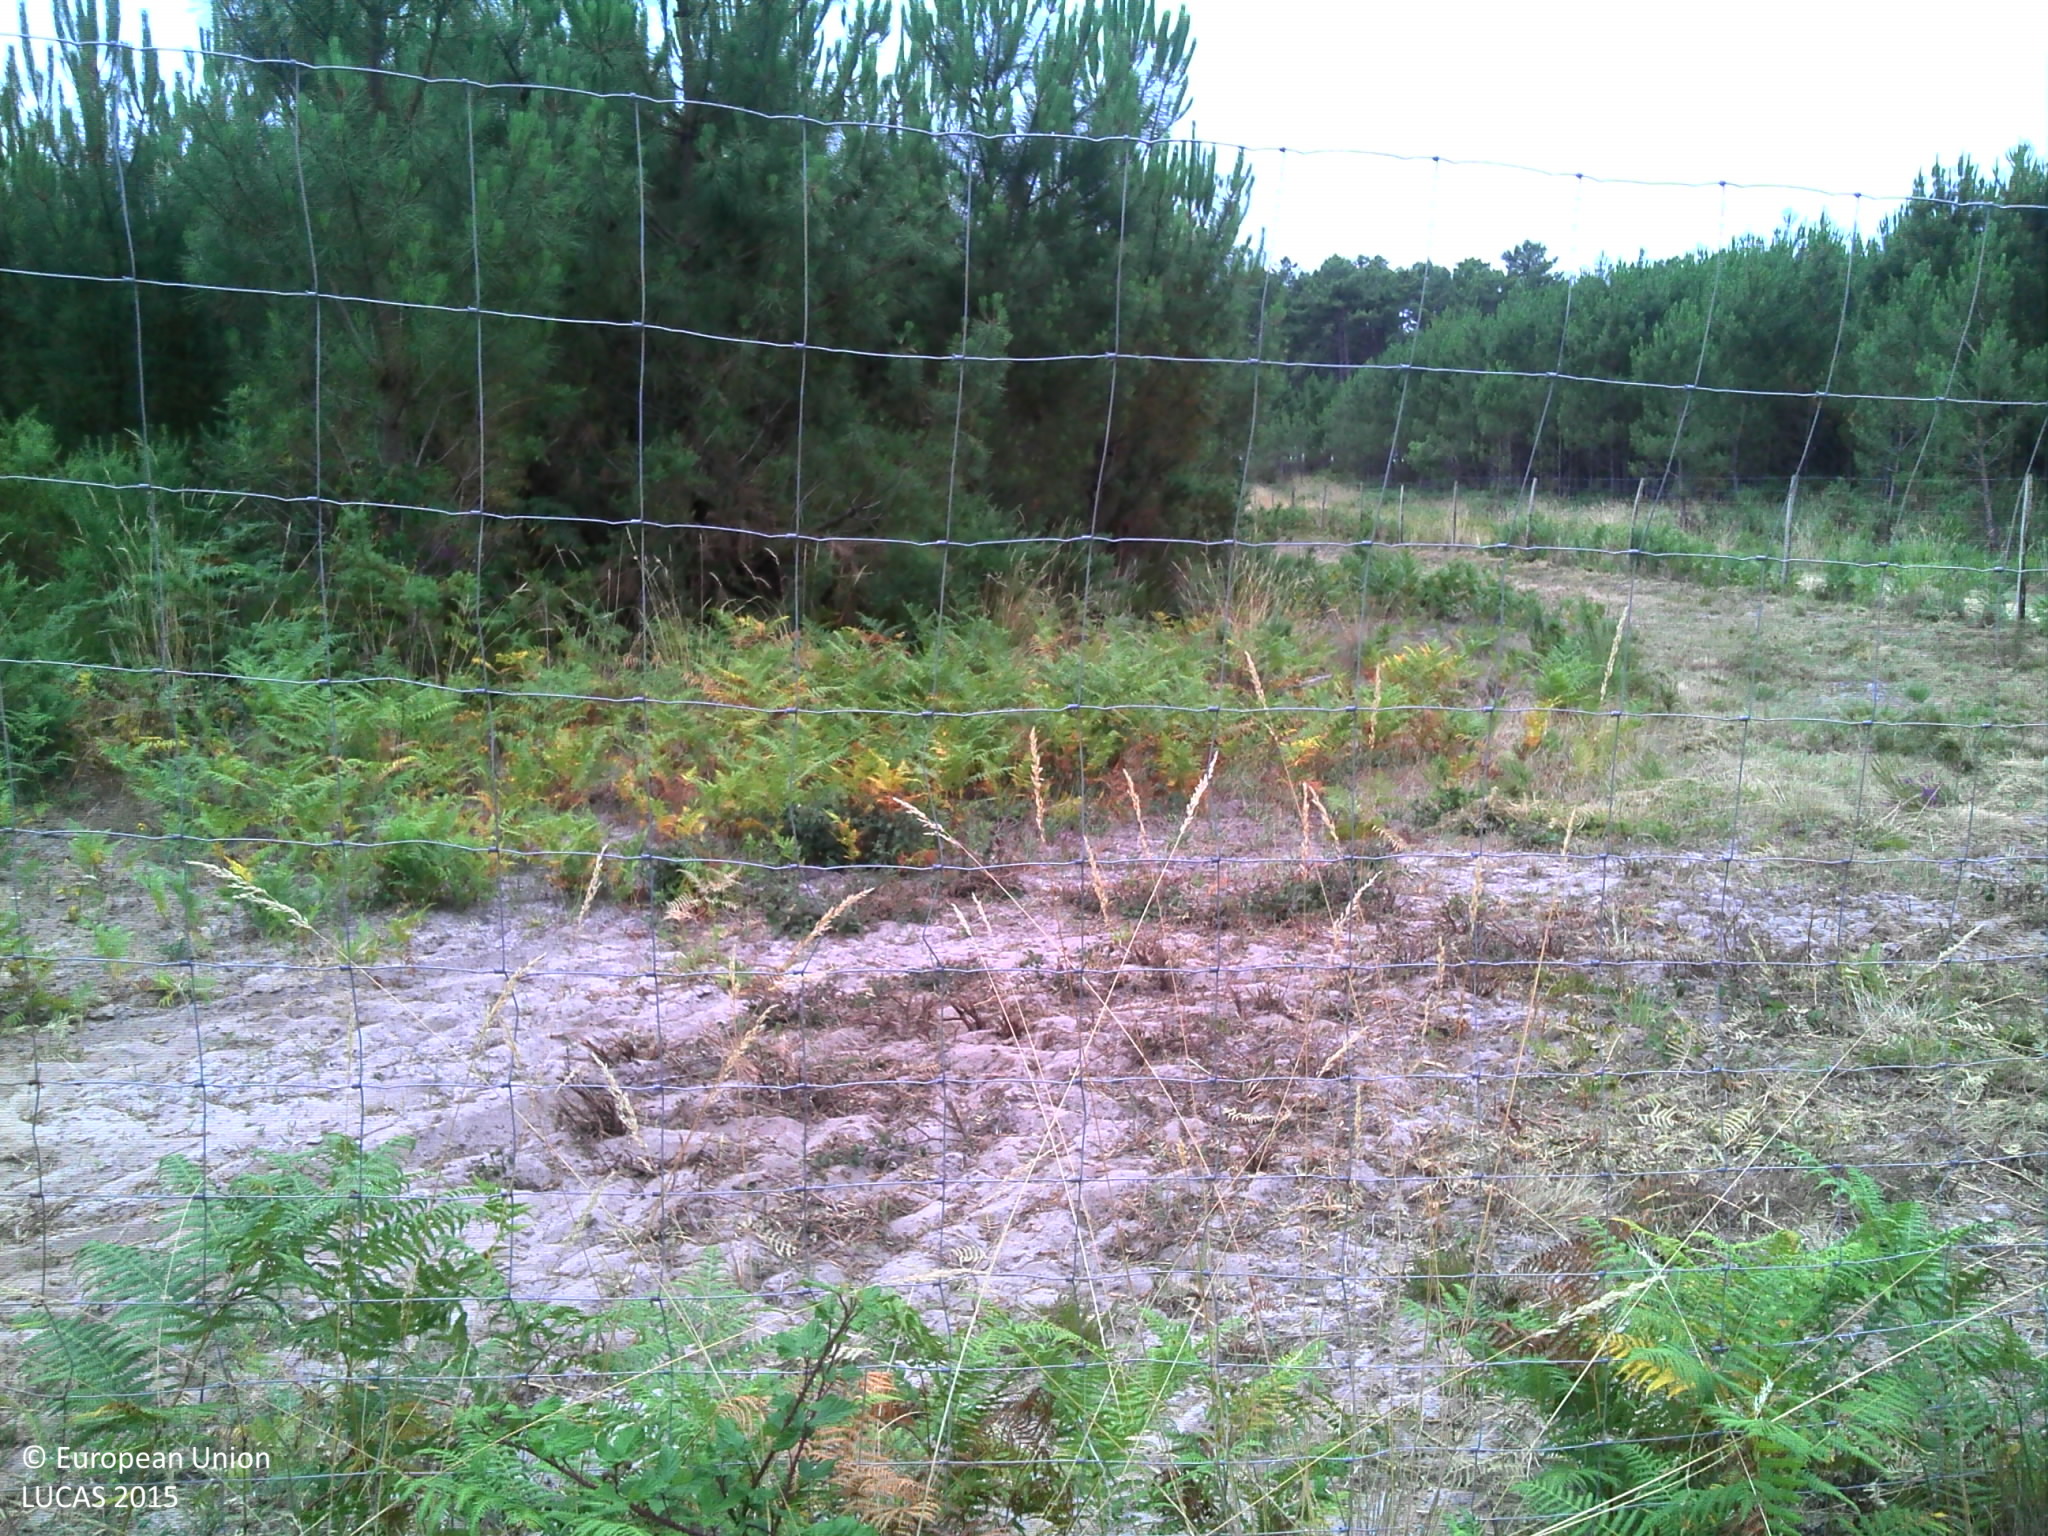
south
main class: Woodland
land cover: Pine dominated coniferous woodland
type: coniferous forest of the mediterranean region
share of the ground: > 75 %
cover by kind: coniferous forest trees 100 %
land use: Forestry
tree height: > 5 m
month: July
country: FR
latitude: 44.2770
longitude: -1.1339
